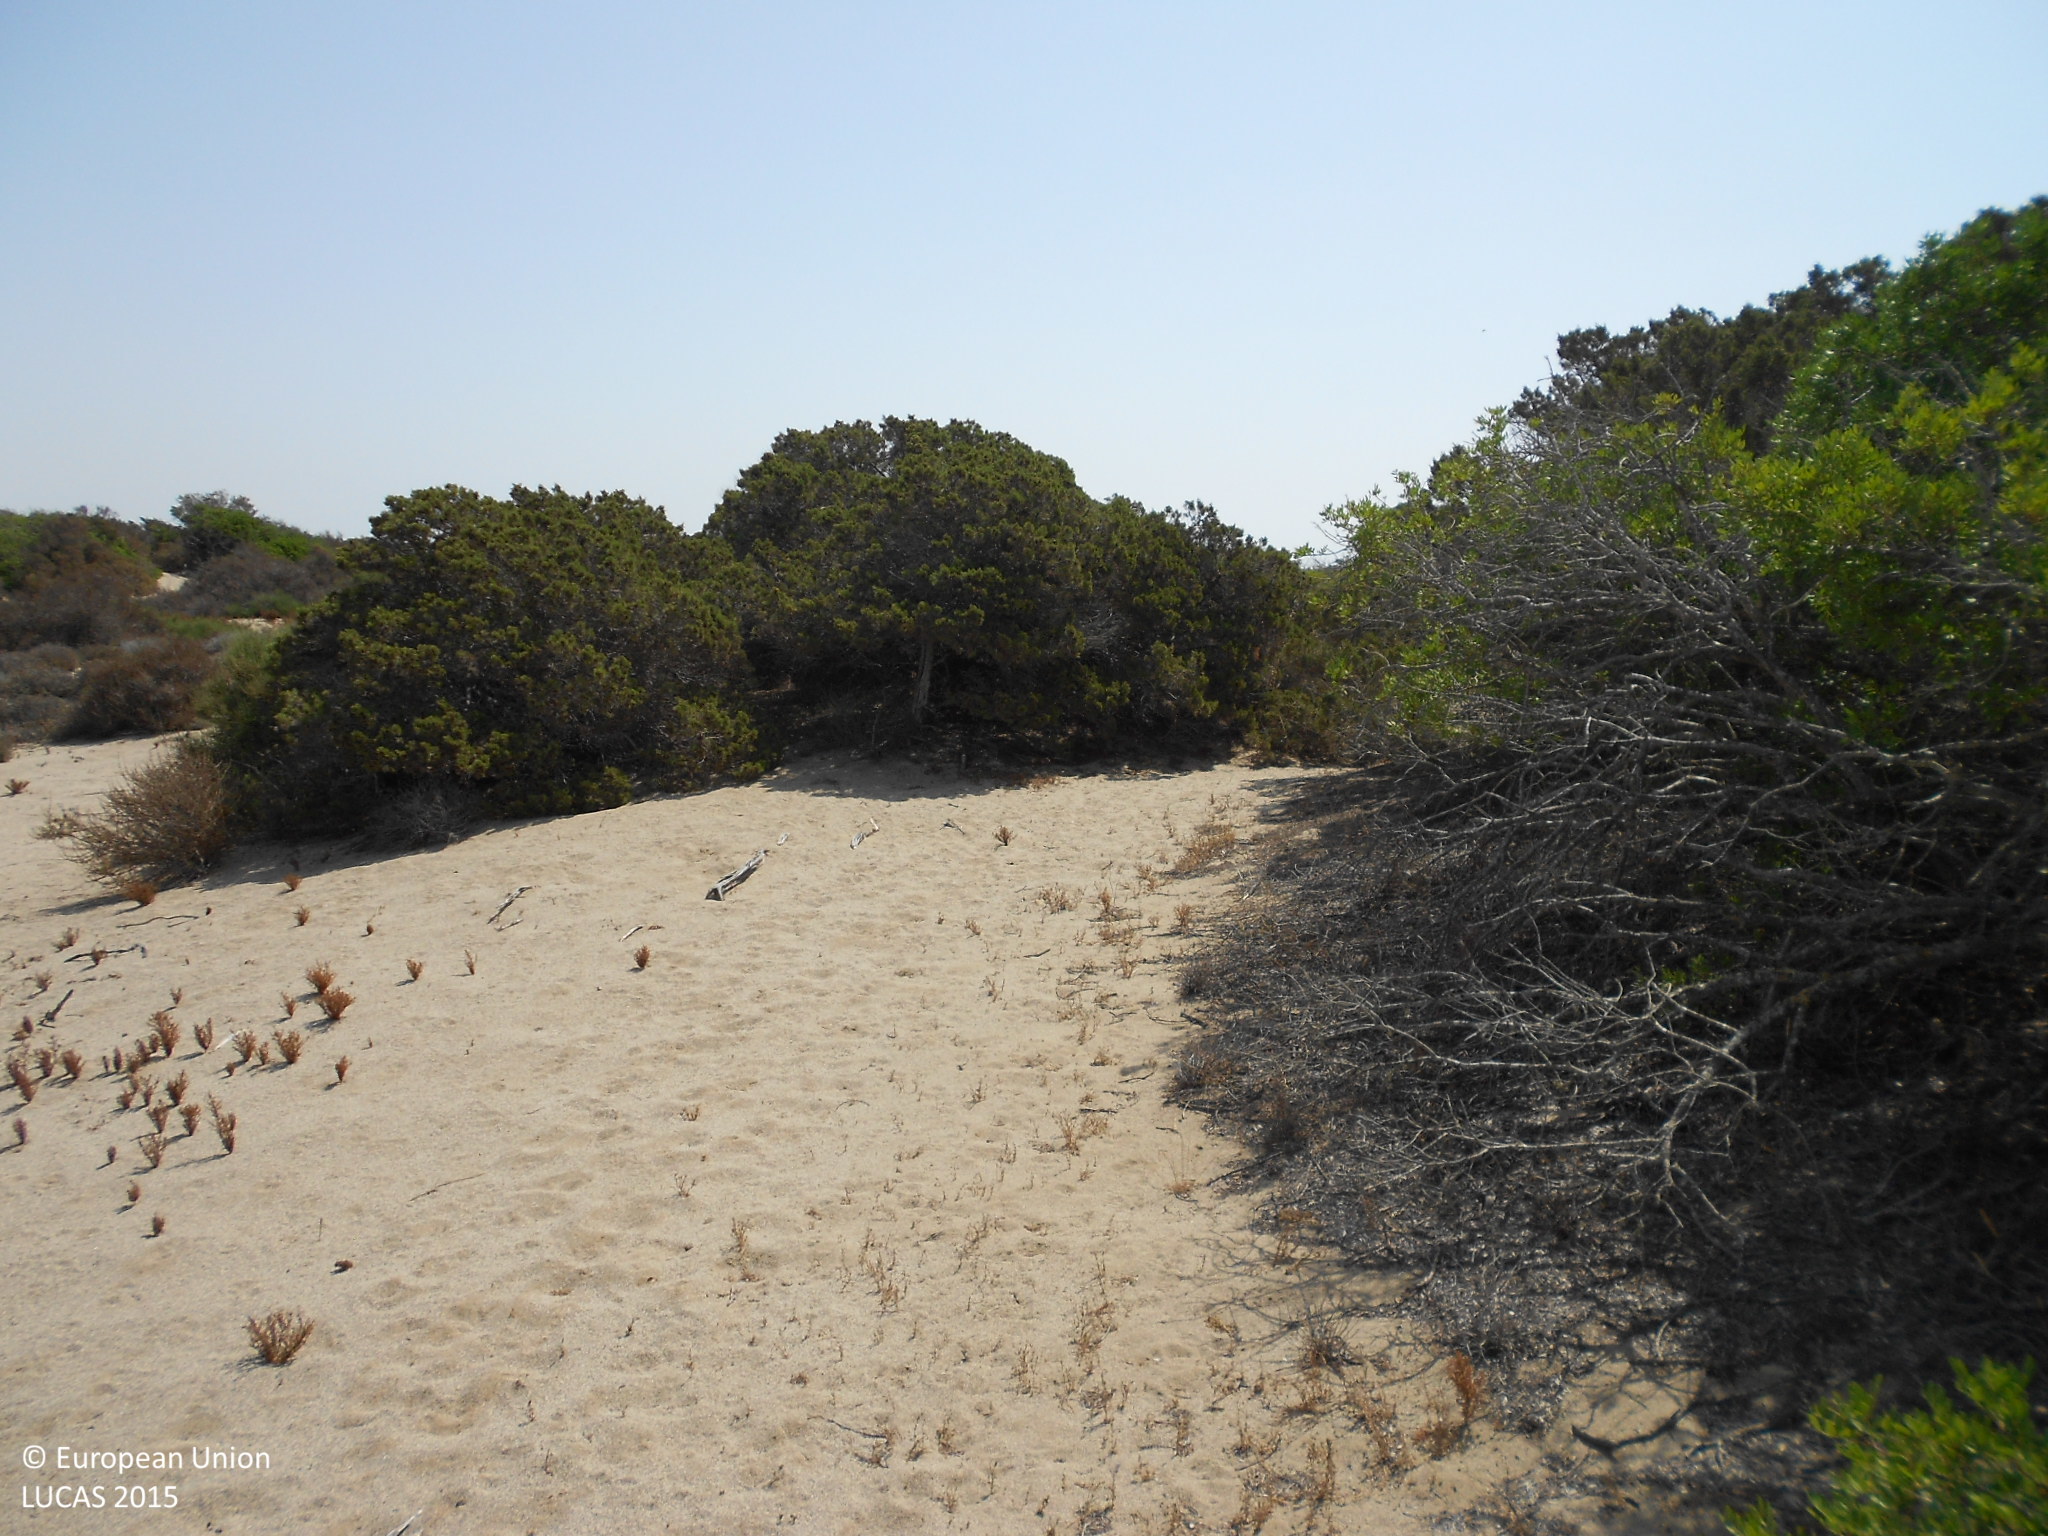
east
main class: Shrubland
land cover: Shrubland without tree cover
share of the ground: 50 - 75 %
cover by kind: shrubs 60 %, unconsolidated bare surface 40 %
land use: Semi-natural and natural areas not in use
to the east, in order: Shrubland without tree cover
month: August
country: ES
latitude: 36.6906
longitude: -2.6995
